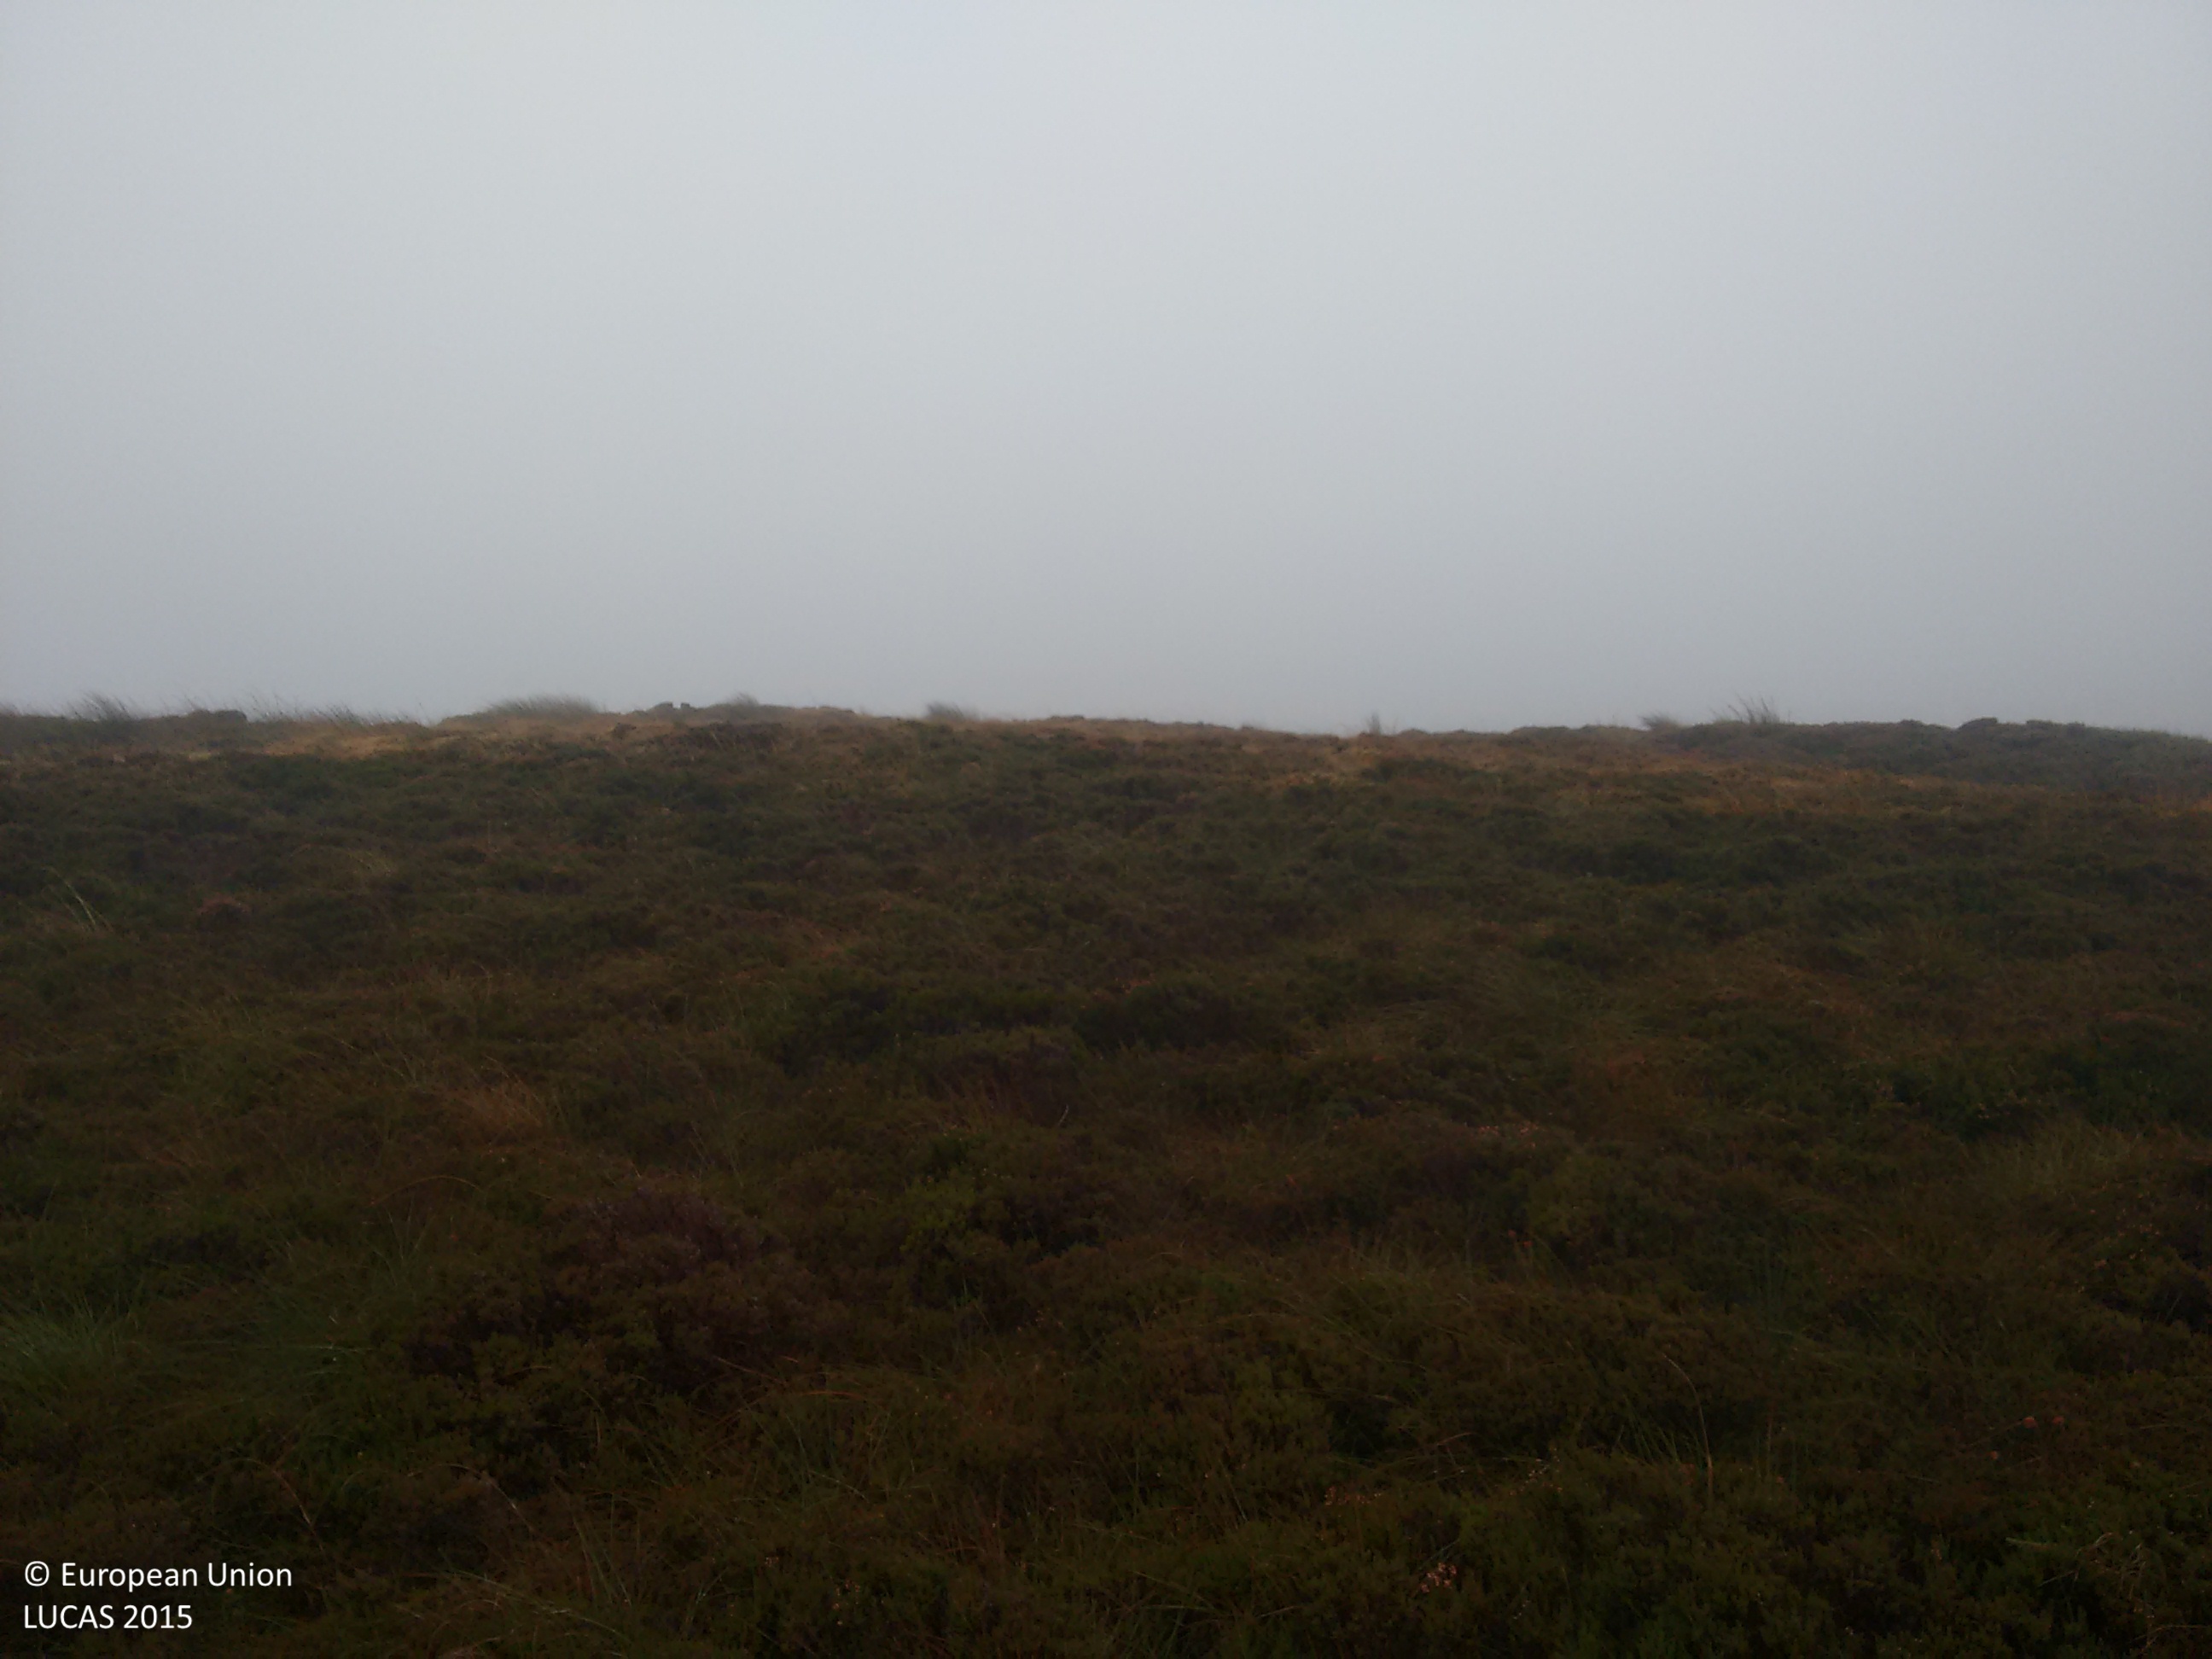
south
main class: Shrubland
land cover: Shrubland without tree cover
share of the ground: > 75 %
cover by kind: shrubs 90 %, herbaceous plants 5 %, lichens and mosses 5 %
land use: Agriculture (excluding fallow land and kitchen gardens)
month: October
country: GB
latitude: 55.6140
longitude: -6.2922
